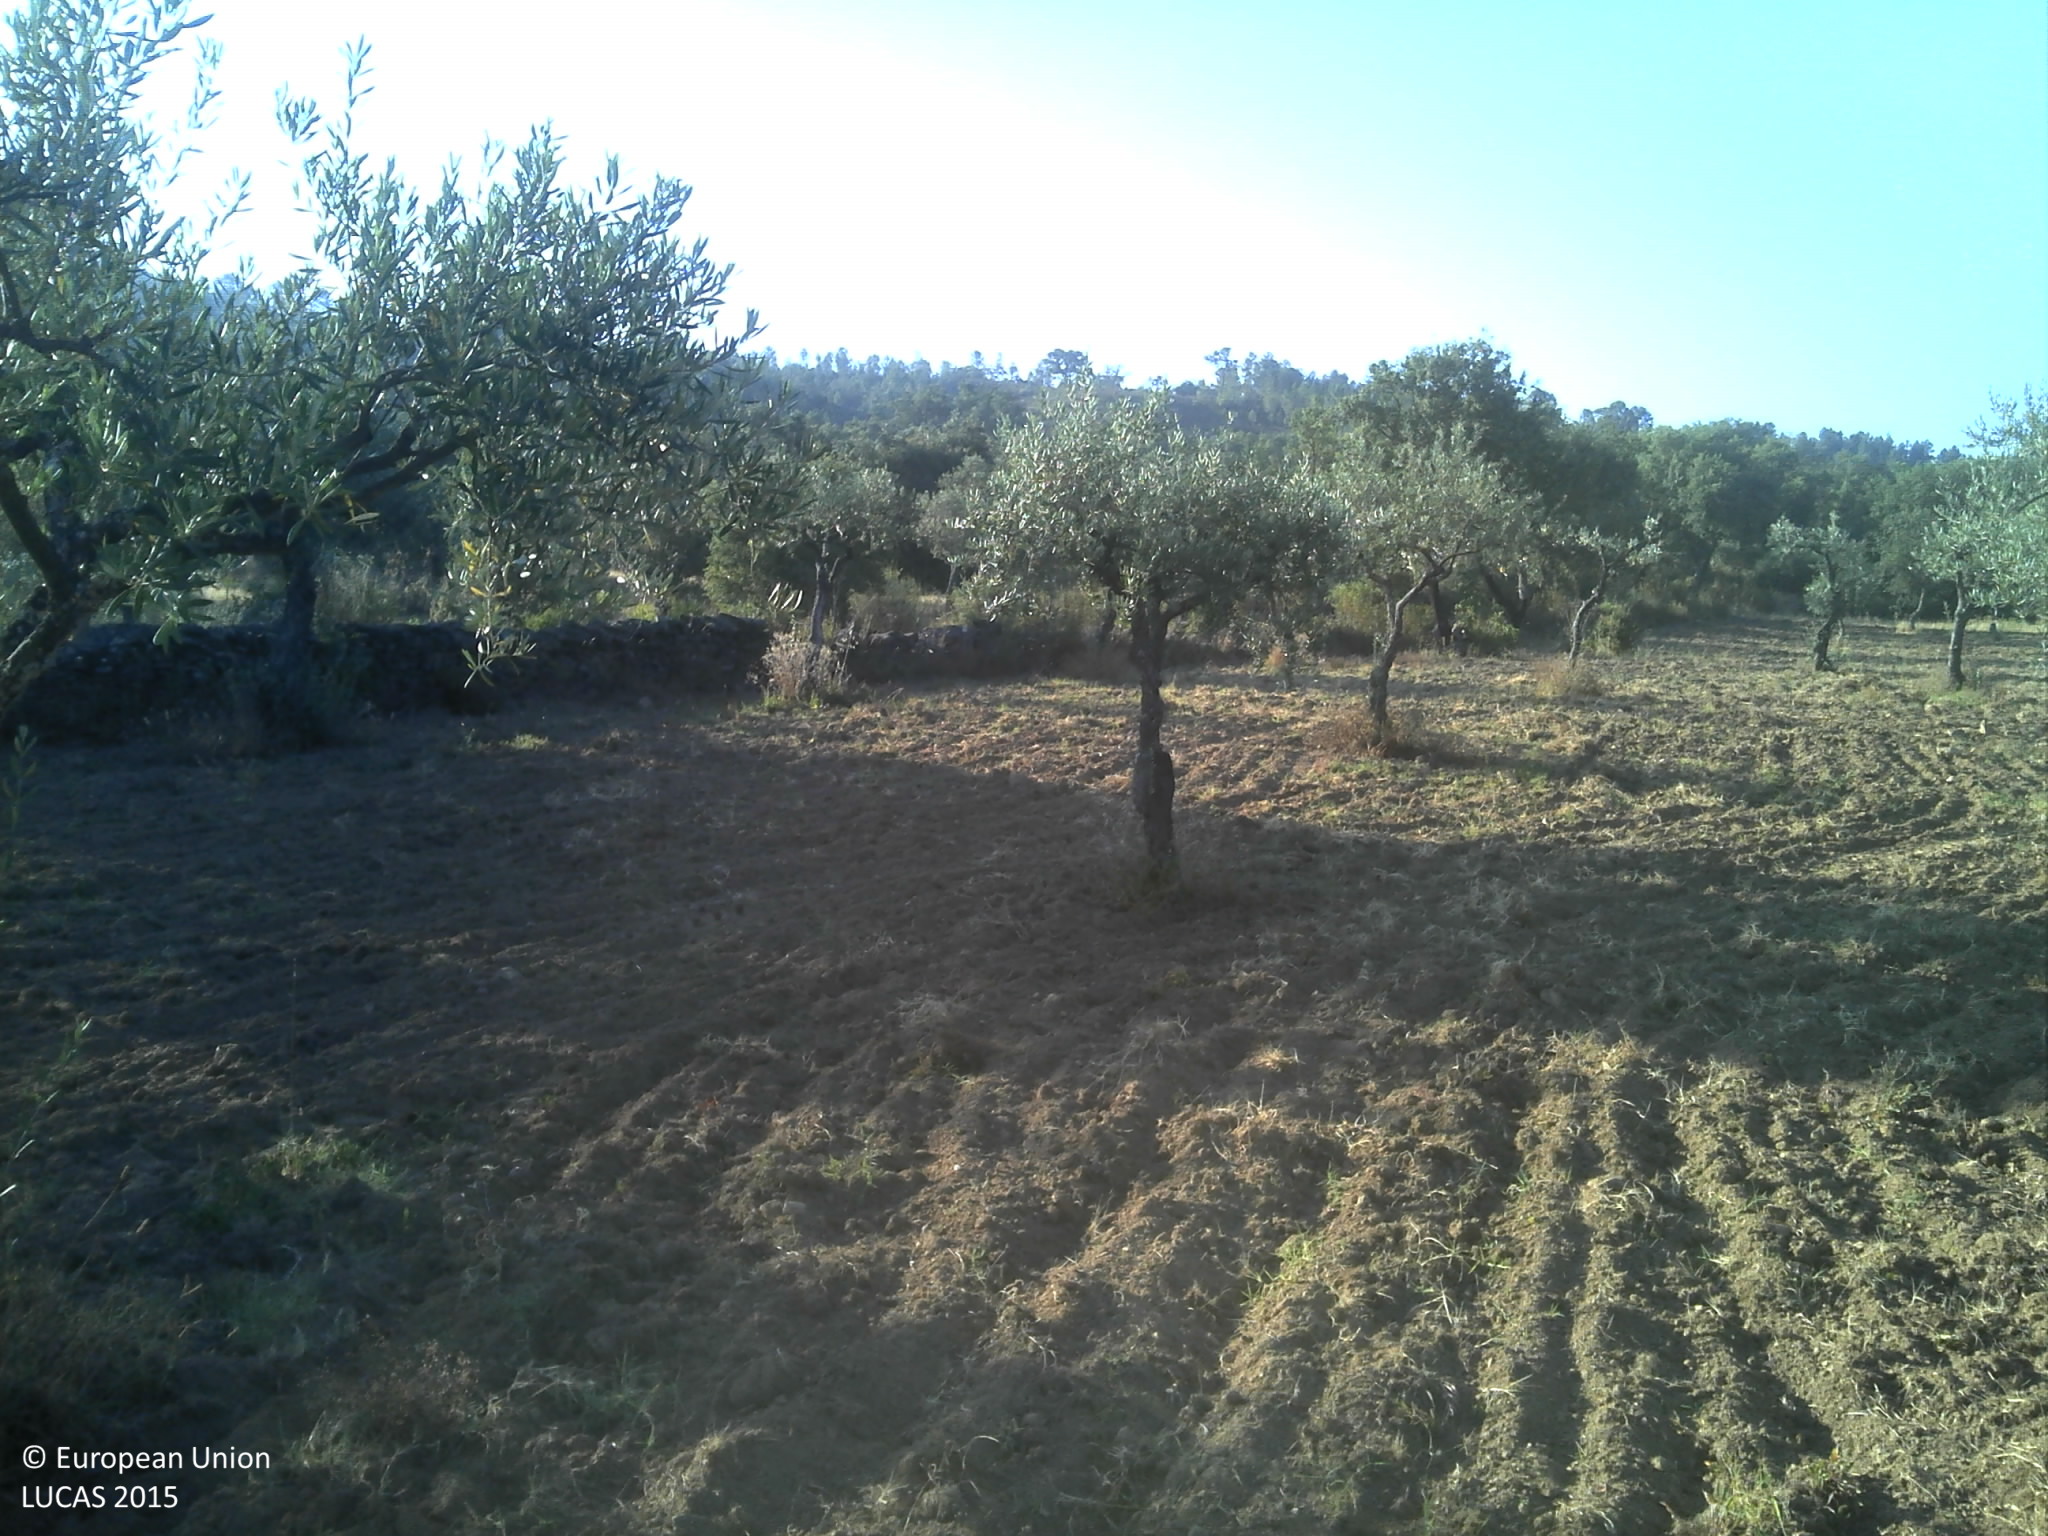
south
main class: Cropland
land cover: Olive groves
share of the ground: 25 - 50 %
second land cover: Other bare soil
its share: > 75 %
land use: Agriculture (excluding fallow land and kitchen gardens)
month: June
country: PT
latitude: 39.9229
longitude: -7.5710
